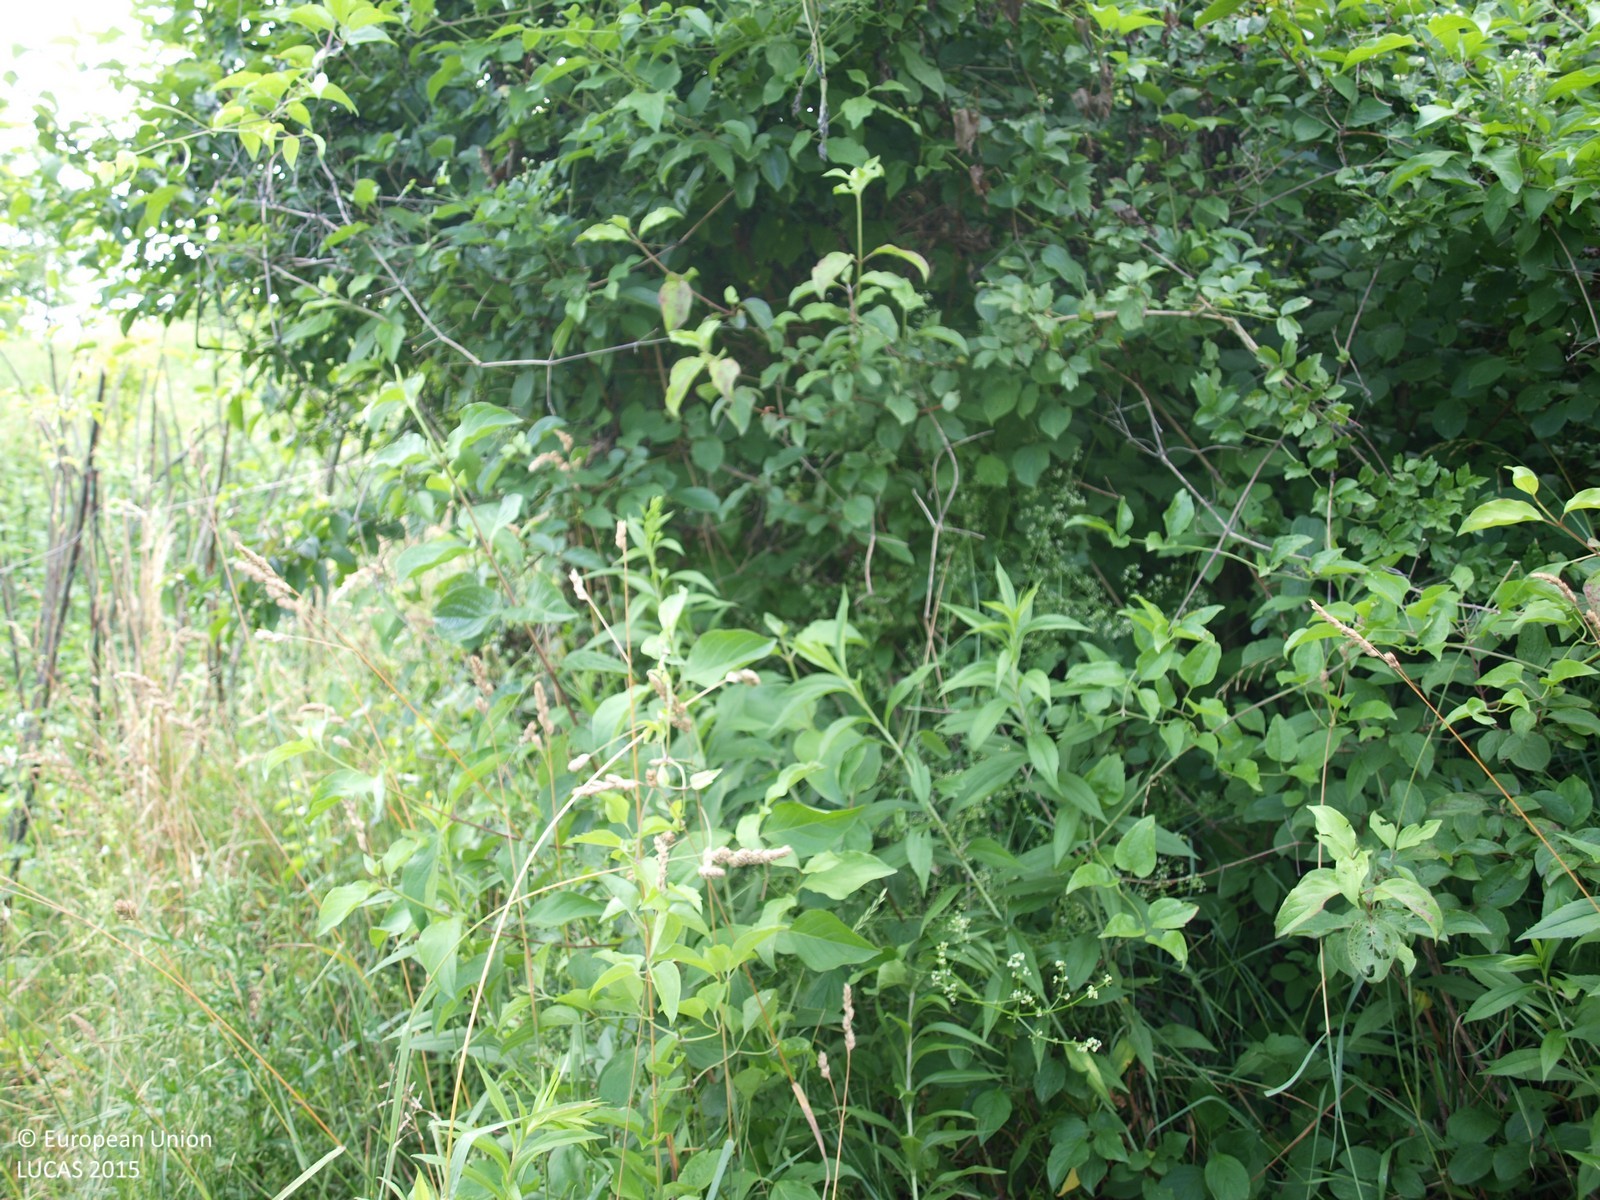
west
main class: Shrubland
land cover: Shrubland with sparse tree cover
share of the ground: > 75 %
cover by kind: shrubs 85 %, herbaceous plants 10 %, broadleaved forest trees 5 %
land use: Abandoned areas
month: June
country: HR
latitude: 46.1815
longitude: 16.3347
